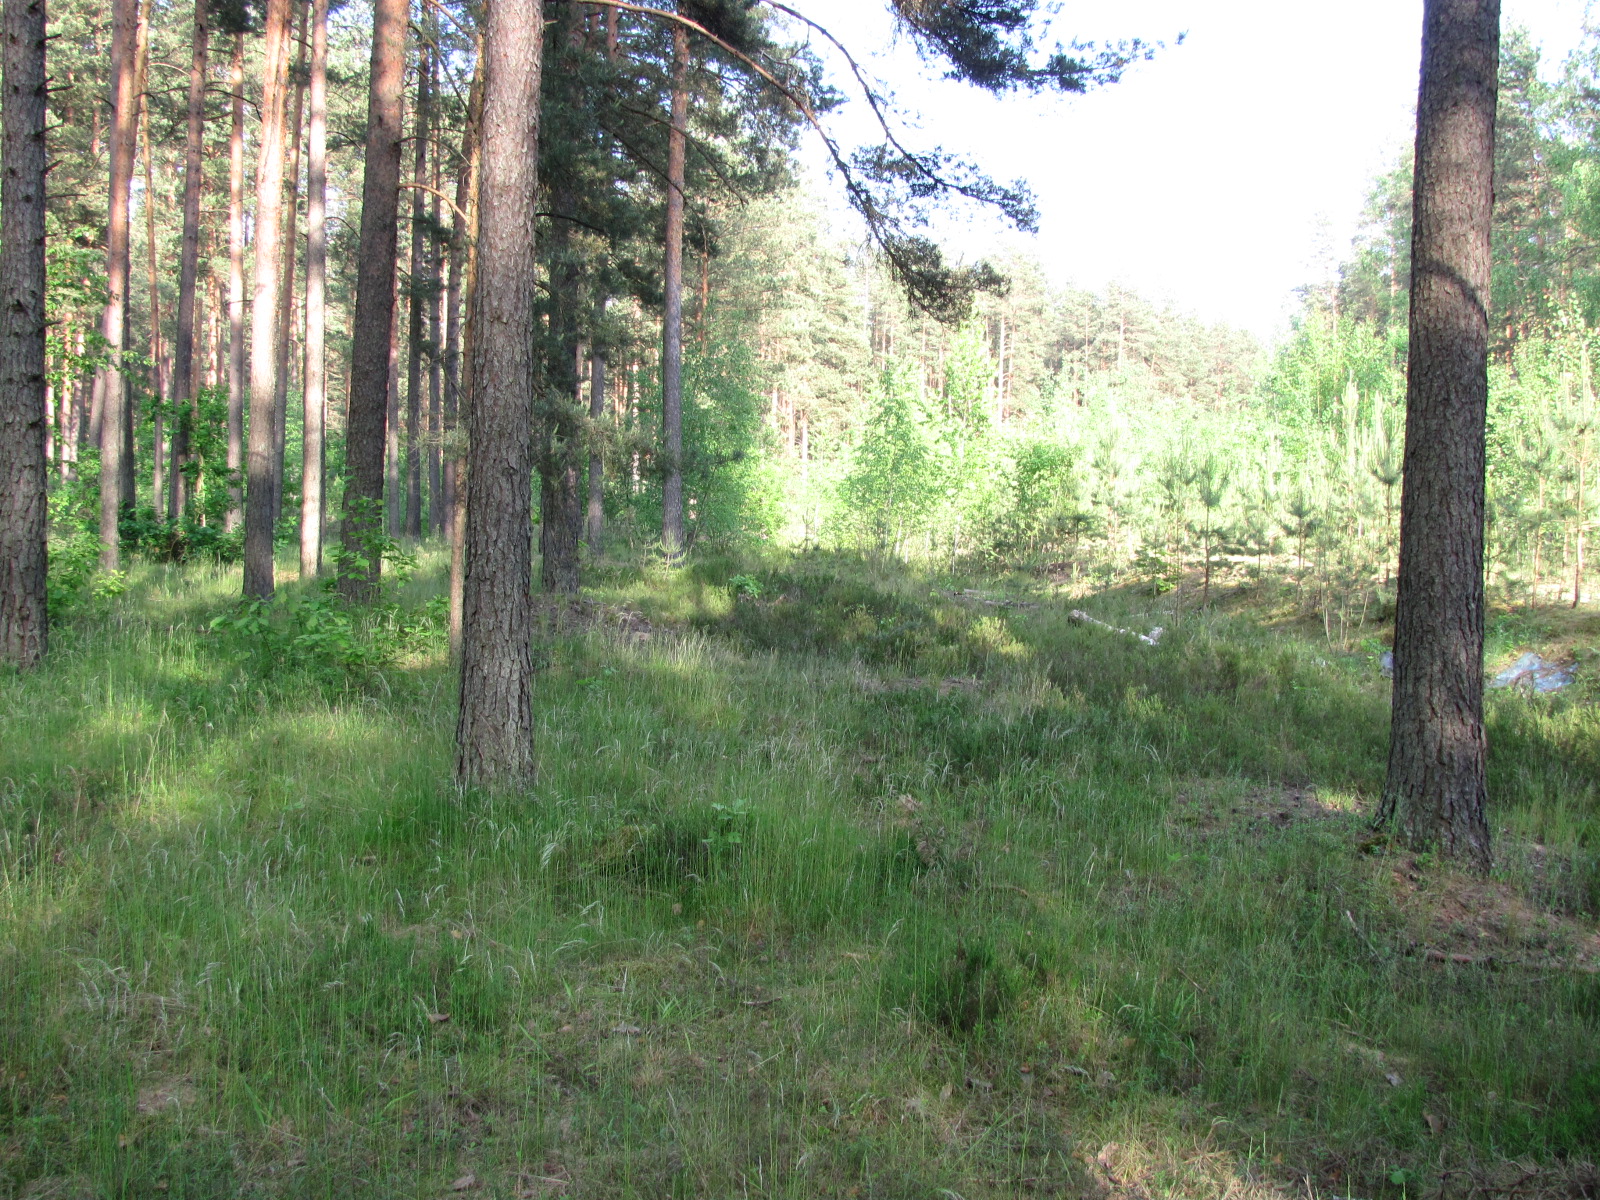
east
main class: Woodland
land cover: Pine dominated coniferous woodland
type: hemiboreal forest and nemoral coniferous forest and mixed broadleaved-coniferous forest
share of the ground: > 75 %
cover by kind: coniferous forest trees 80 %, herbaceous plants 10 %, lichens and mosses 10 %
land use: Forestry
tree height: > 5 m
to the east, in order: Pine dominated coniferous woodland; Artificial constructions; Pine dominated mixed woodland; Paved roads, cycling and walking lanes; Pine dominated mixed woodland
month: June
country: LV
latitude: 56.9183
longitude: 24.2987
